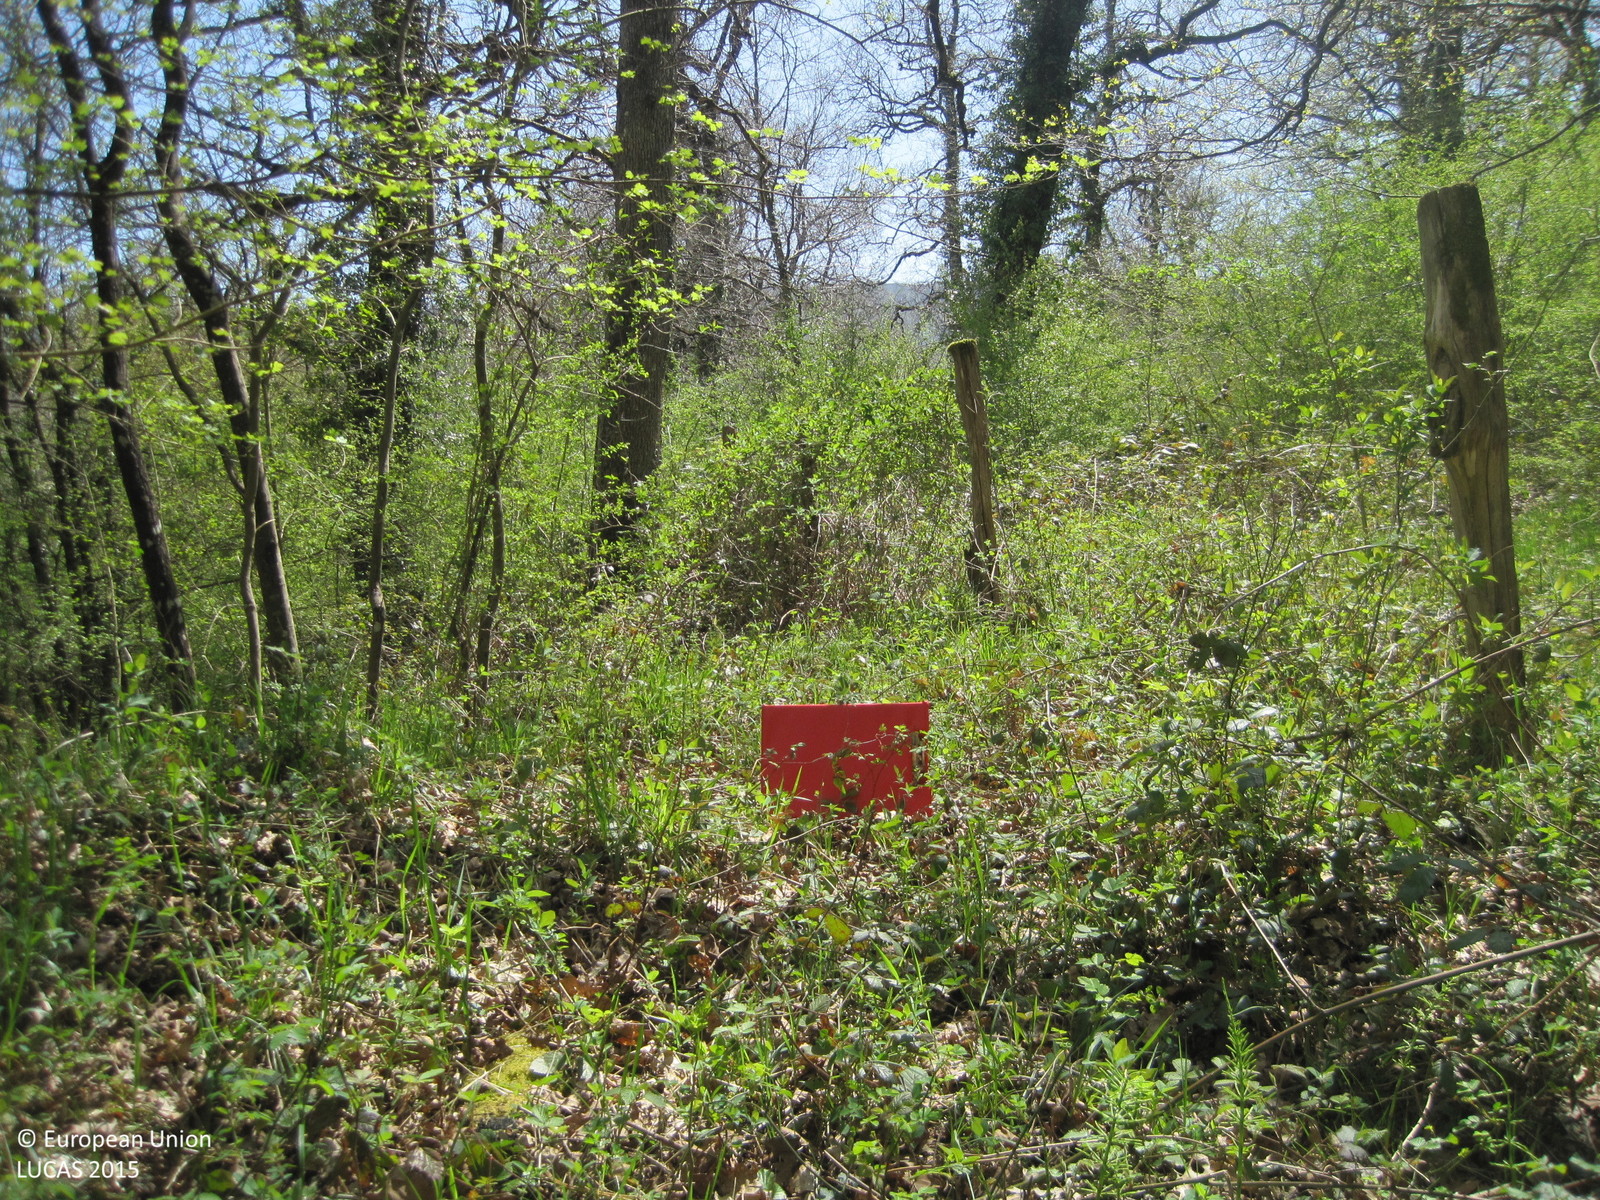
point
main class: Woodland
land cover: Broadleaved woodland
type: acidophilous oak and oak-birch forest
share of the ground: > 75 %
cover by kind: broadleaved forest trees 100 %
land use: Forestry
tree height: > 5 m
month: April
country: ES
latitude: 42.8770
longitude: -2.2272
